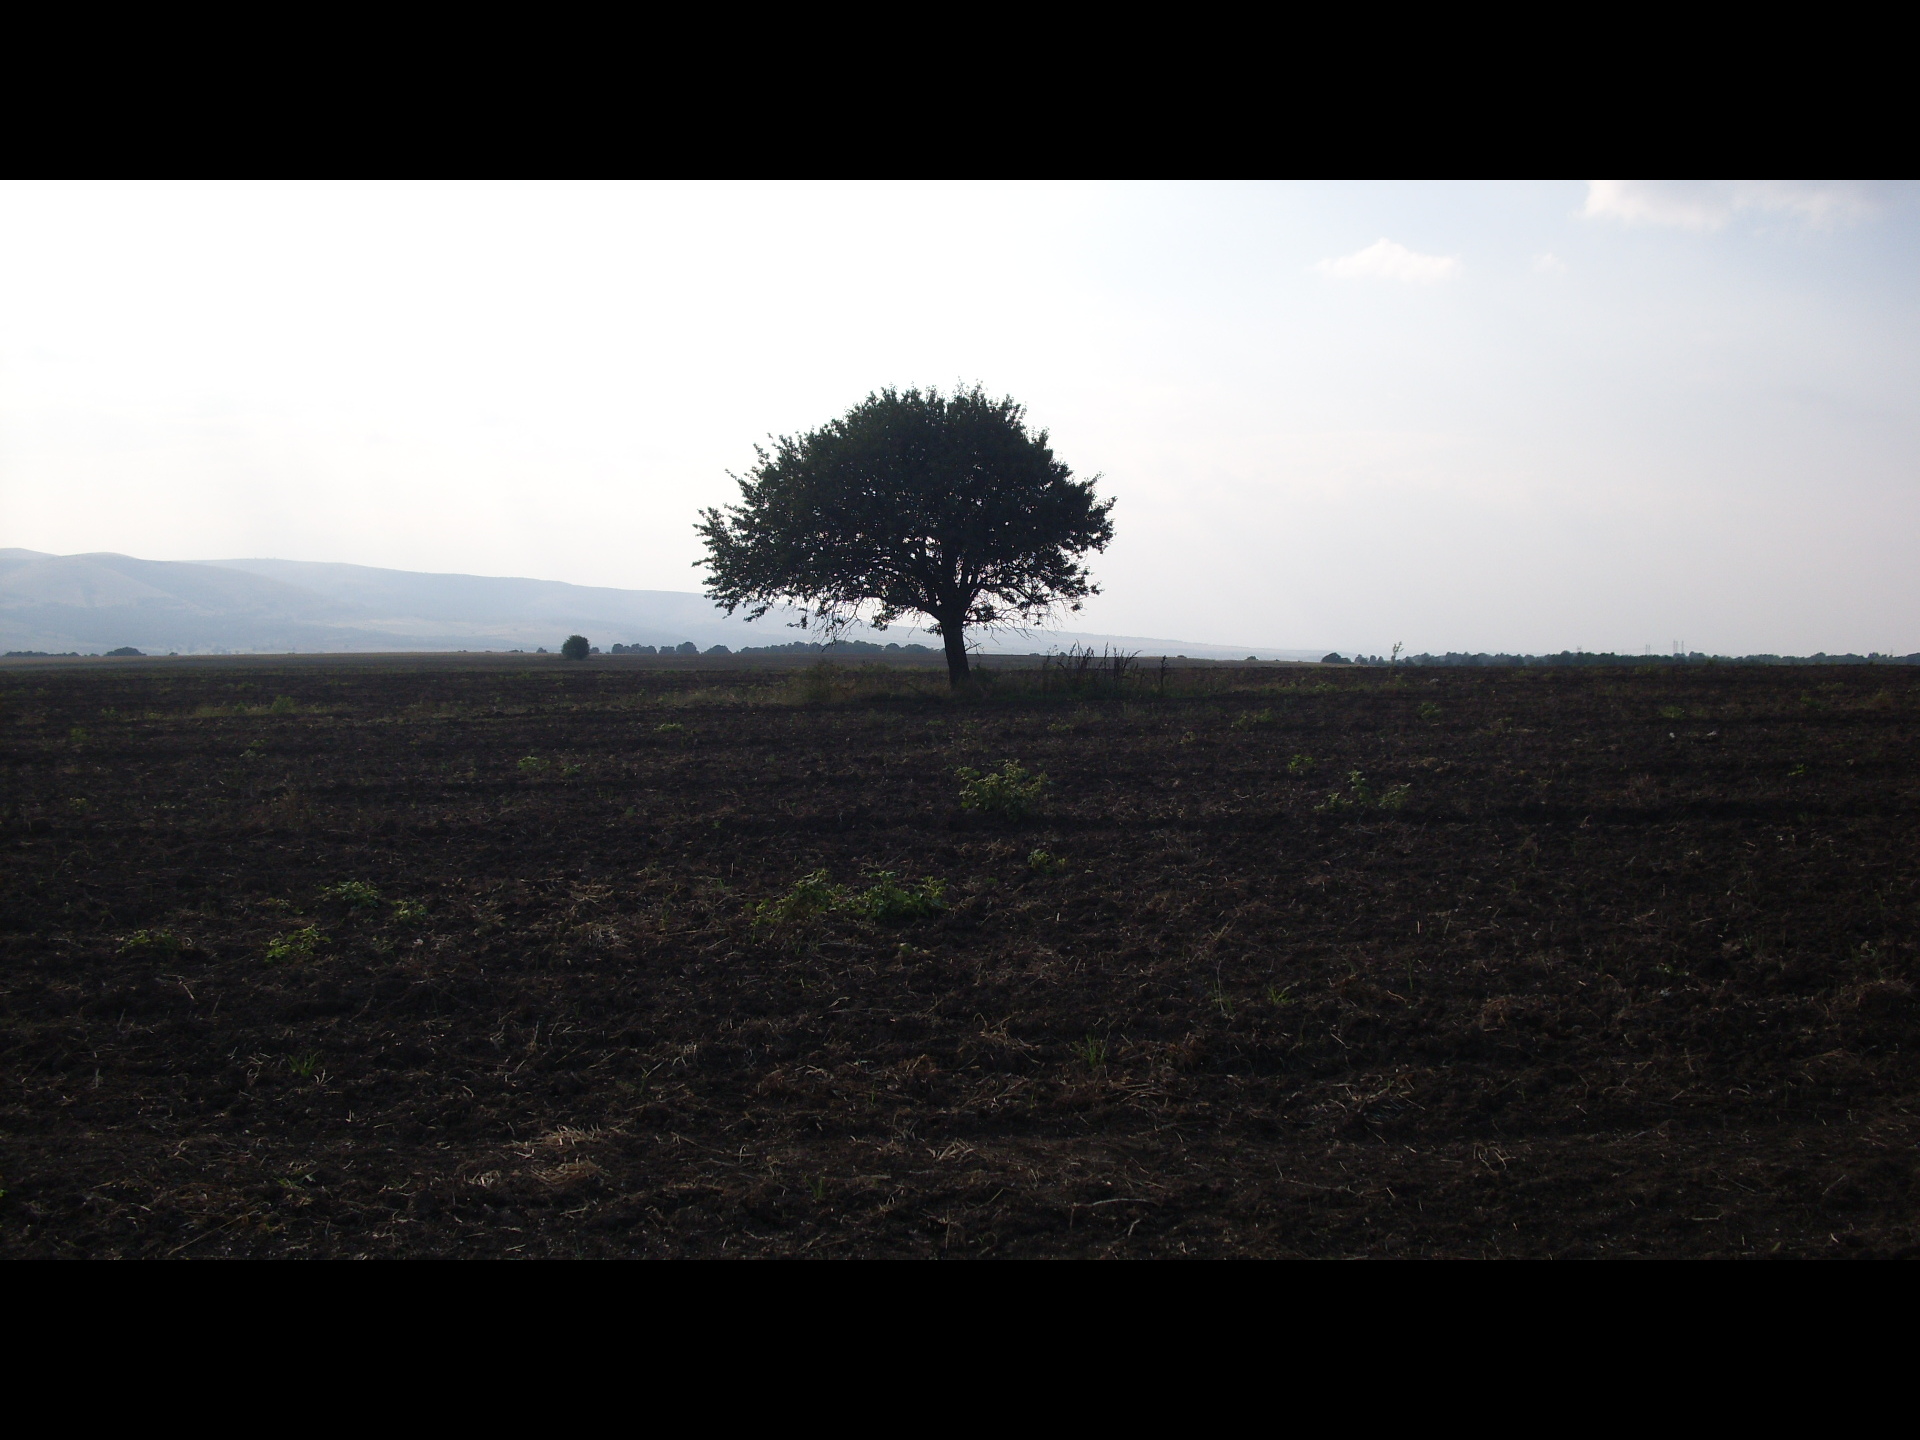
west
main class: Cropland
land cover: Rape and turnip rape
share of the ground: < 10 %
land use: Agriculture (excluding fallow land and kitchen gardens)
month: September
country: BG
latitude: 43.4583
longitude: 23.4028
